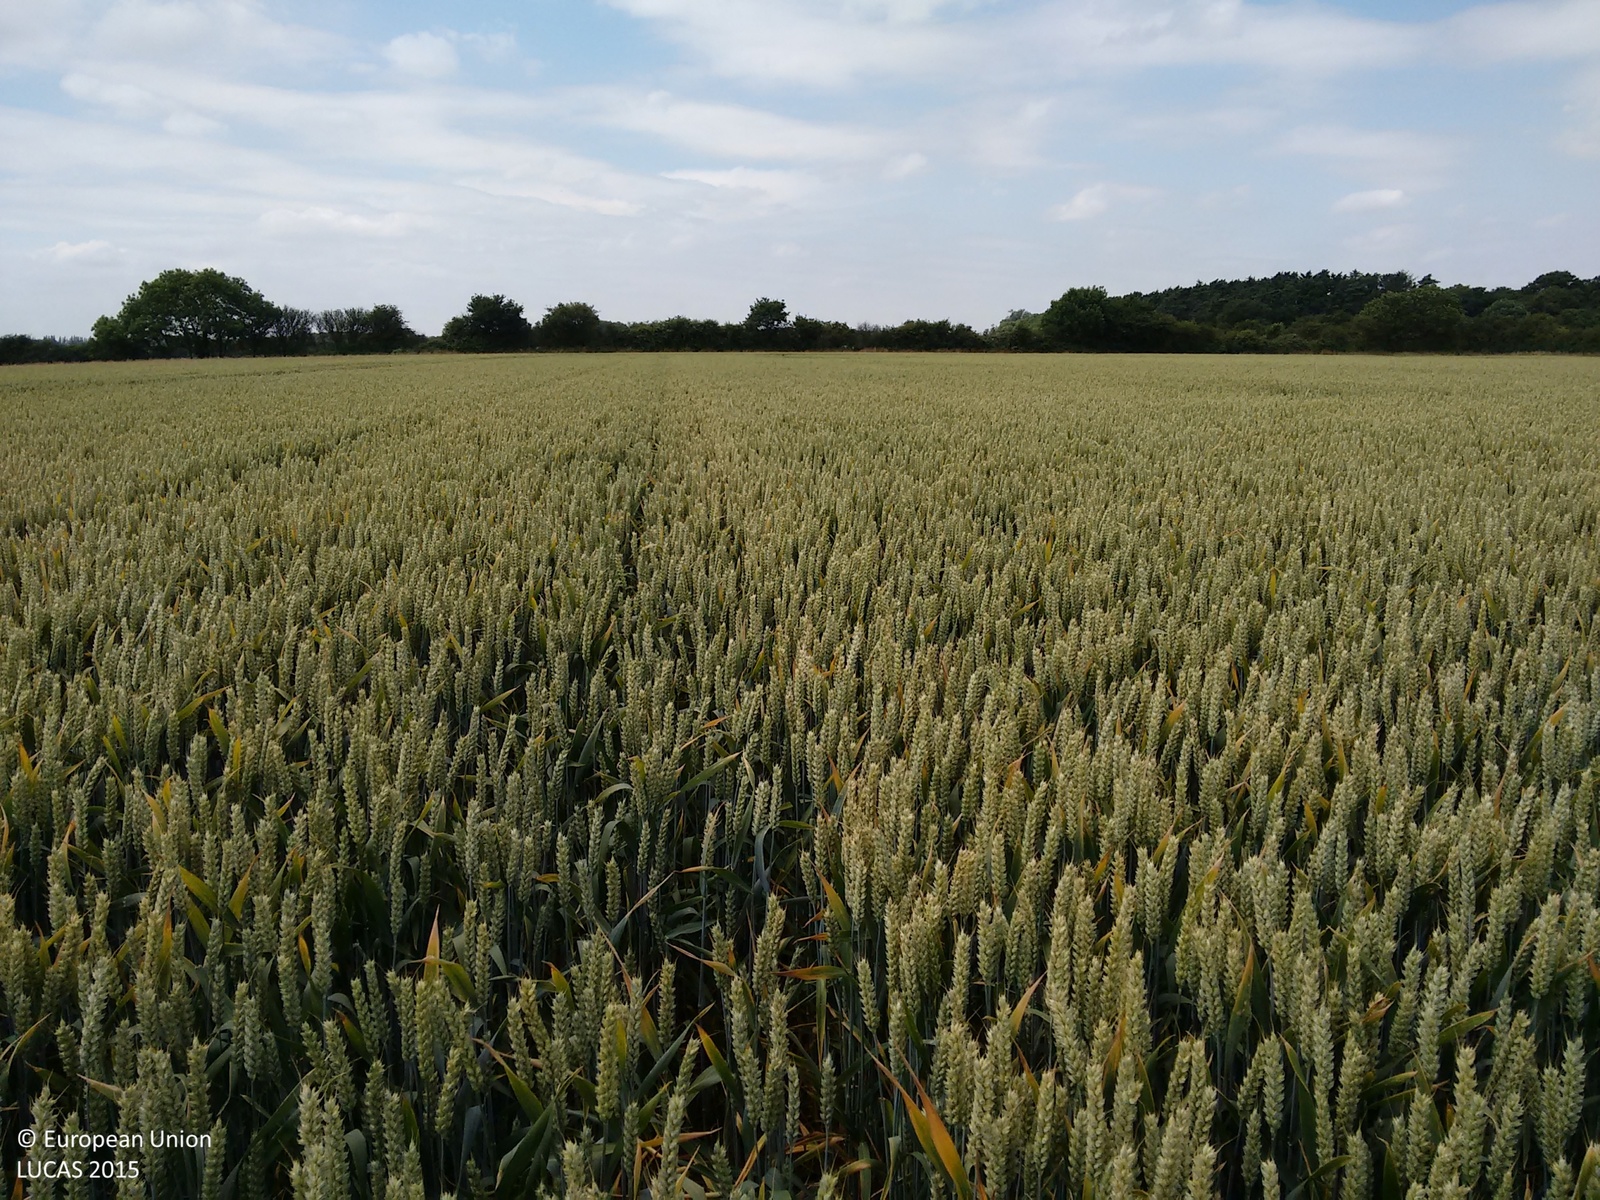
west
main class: Cropland
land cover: Common wheat
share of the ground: > 75 %
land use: Agriculture (excluding fallow land and kitchen gardens)
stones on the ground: < 10 %
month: July
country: GB
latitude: 52.4690
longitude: -0.7427
